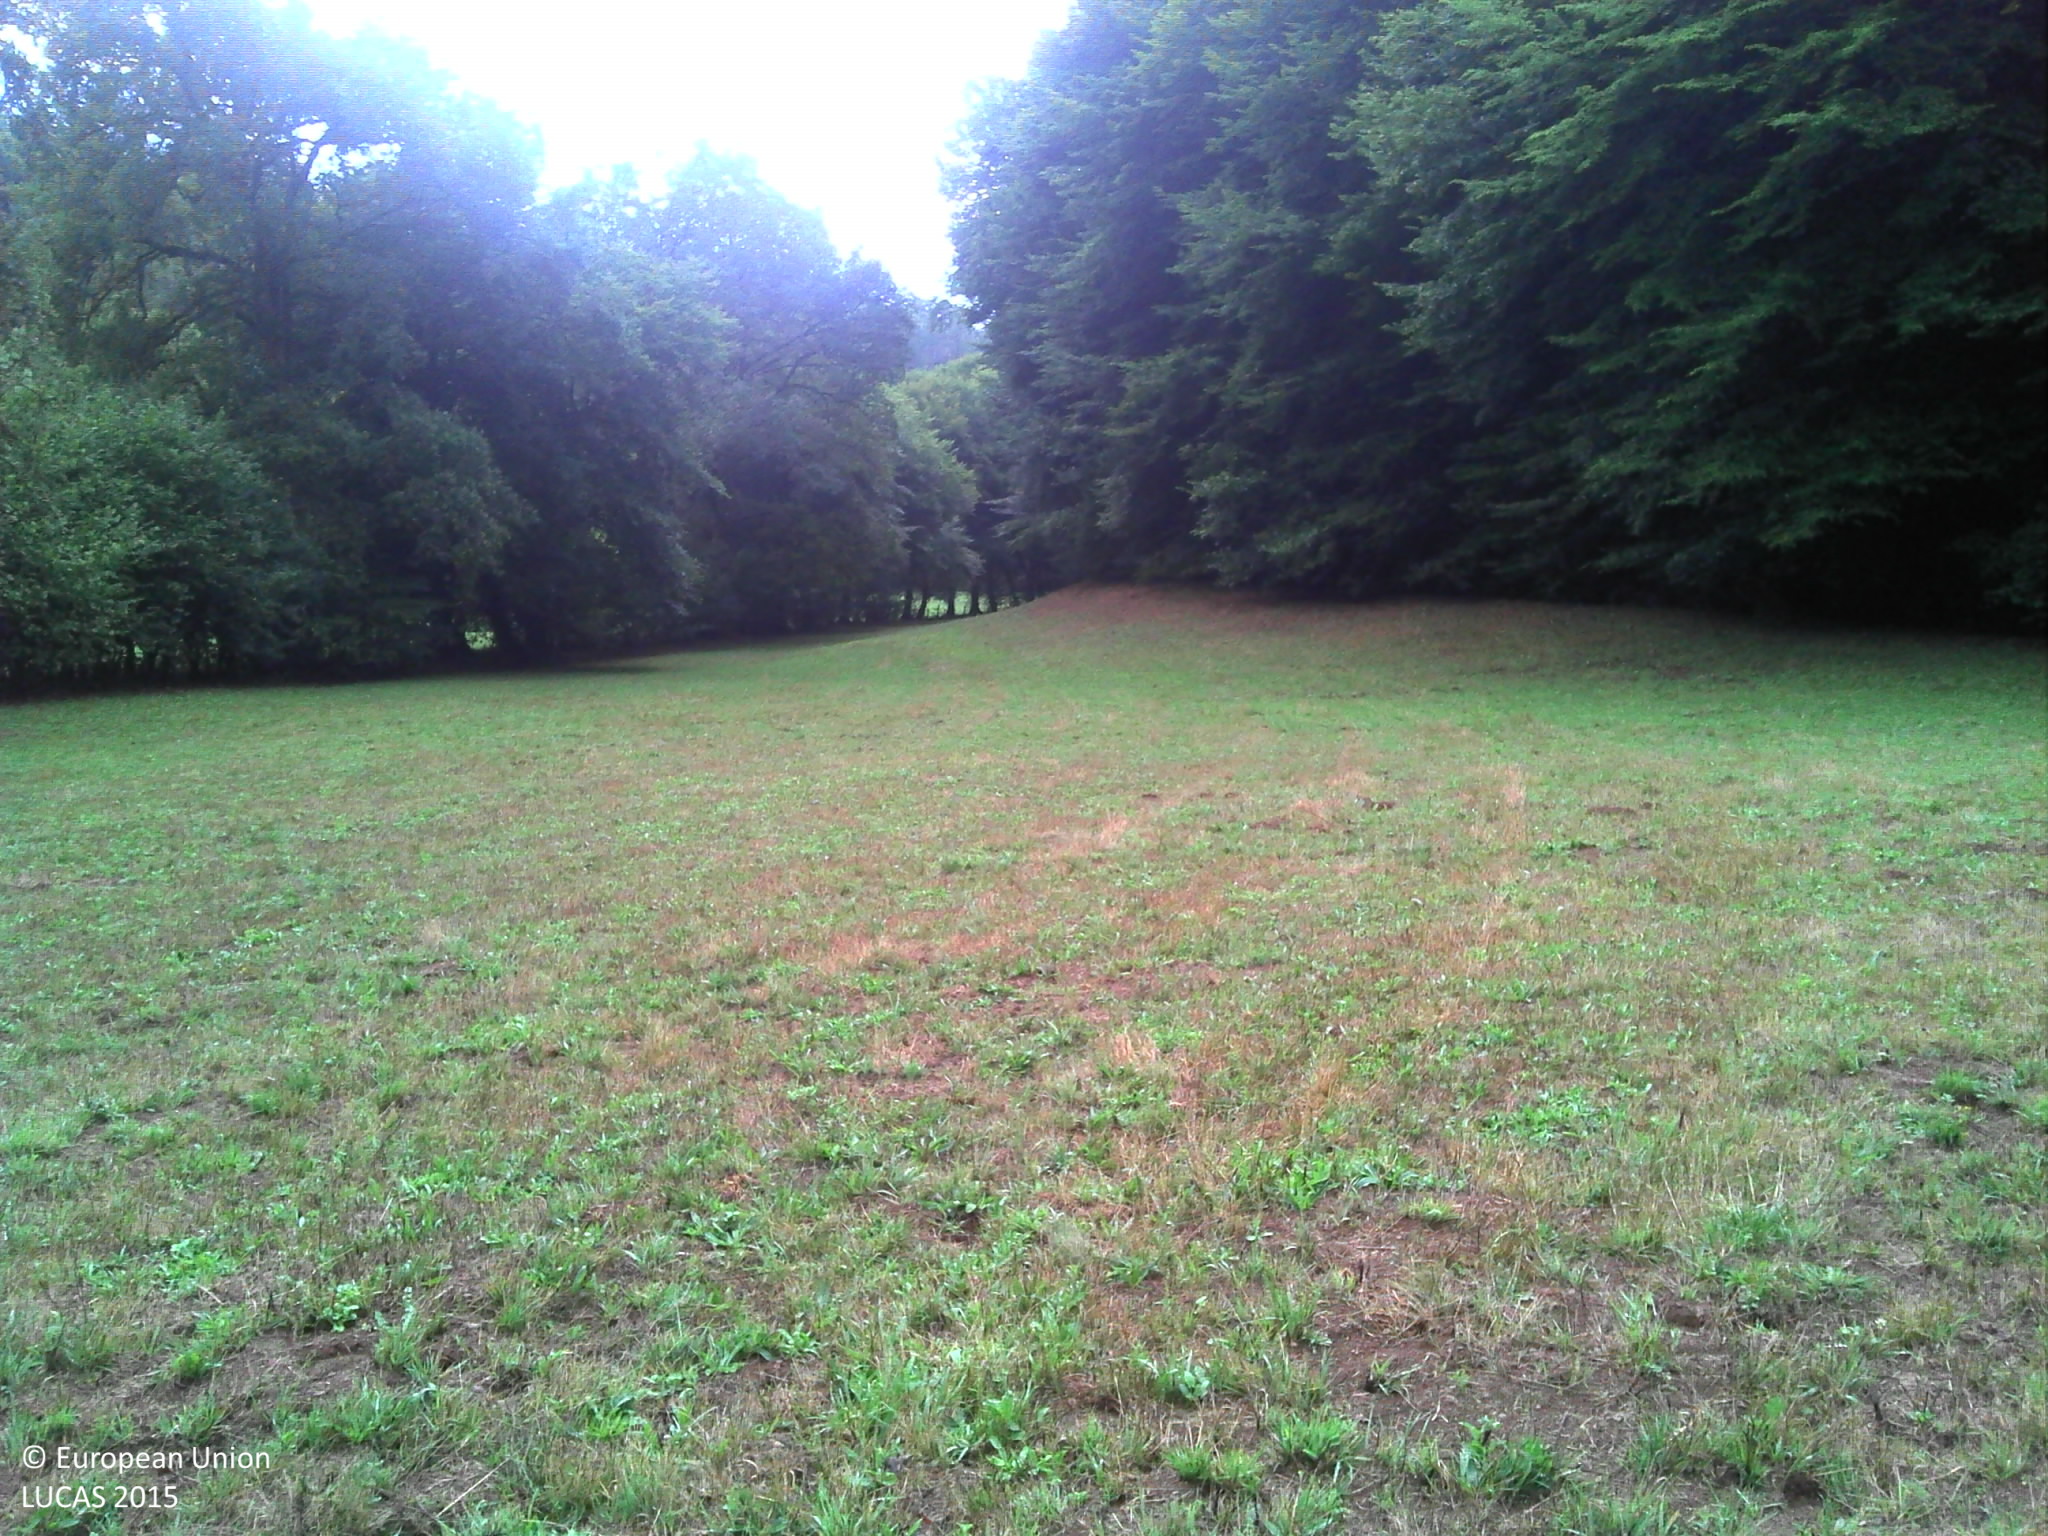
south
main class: Grassland
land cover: Grassland without tree/shrub cover
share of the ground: > 75 %
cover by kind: herbaceous plants 100 %
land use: Agriculture (excluding fallow land and kitchen gardens)
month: August
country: FR
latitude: 45.3492
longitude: 1.8145
